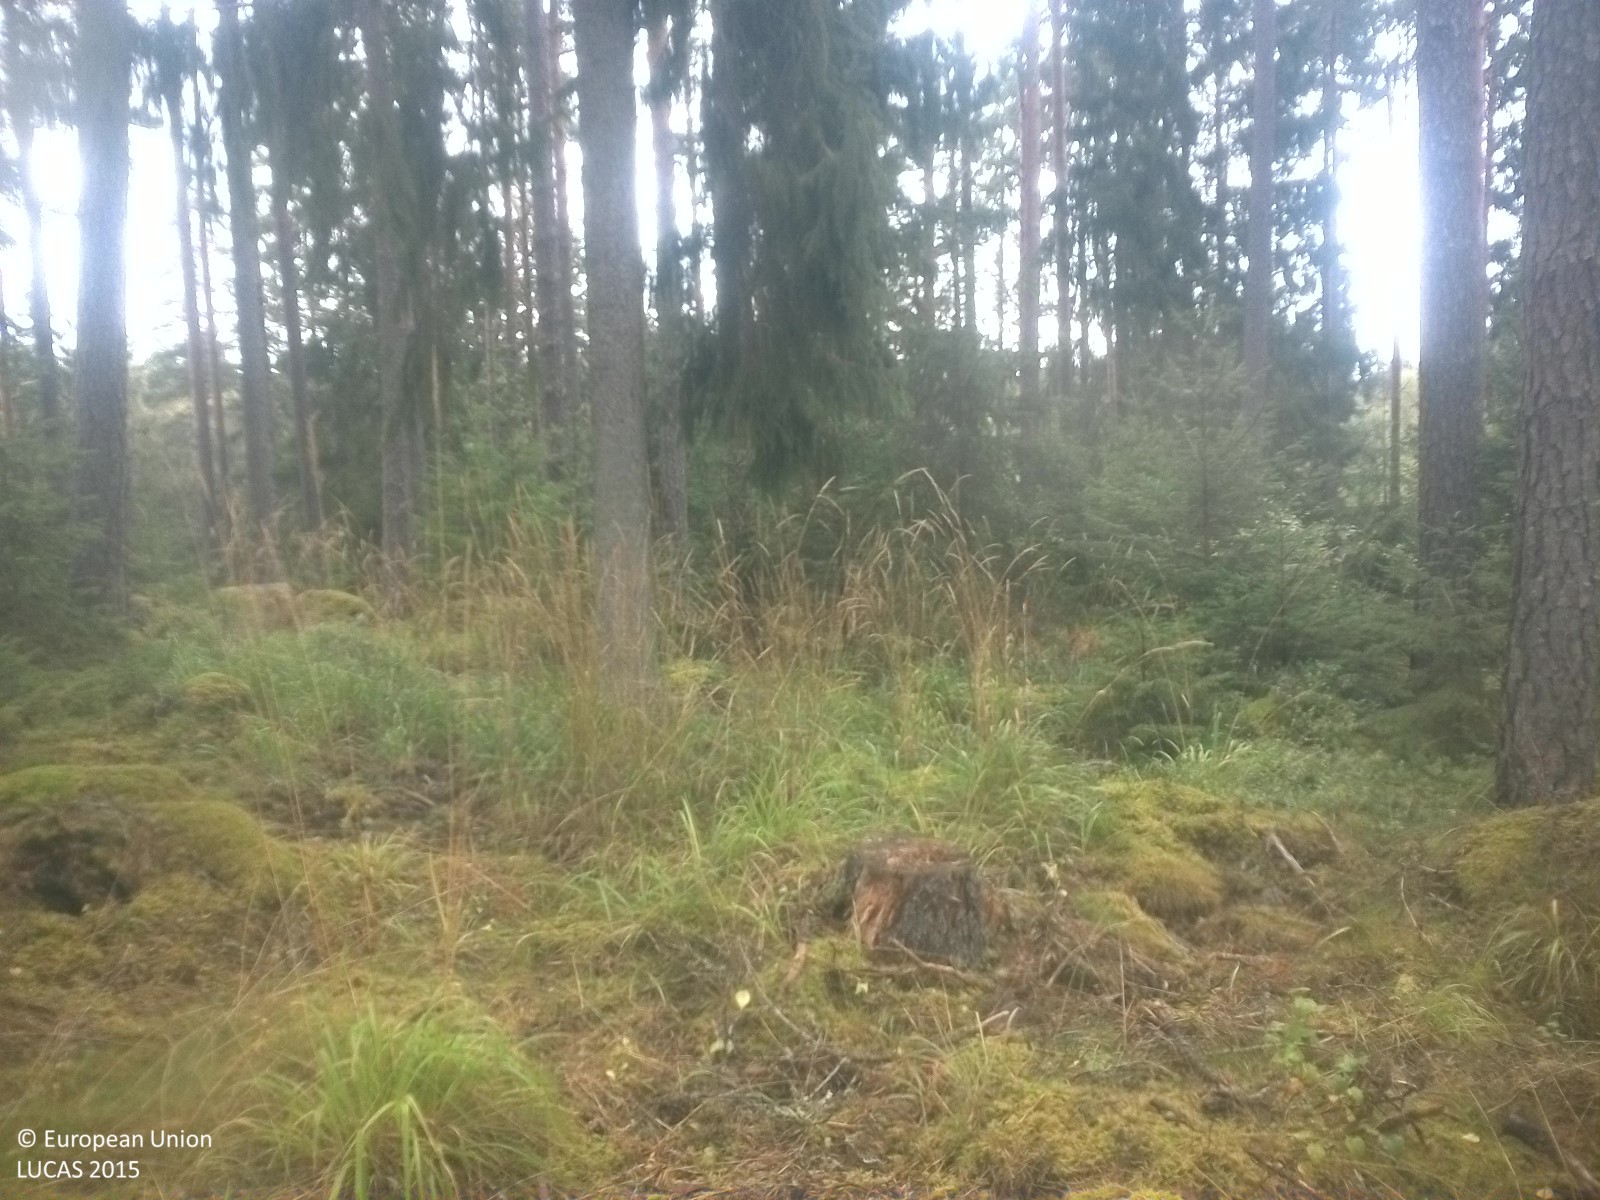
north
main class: Woodland
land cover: Pine dominated coniferous woodland
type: boreal forest
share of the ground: 25 - 50 %
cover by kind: lichens and mosses 55 %, coniferous forest trees 30 %, herbaceous plants 15 %
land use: Forestry
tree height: > 5 m
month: September
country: SE
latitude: 59.3820
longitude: 15.6421
